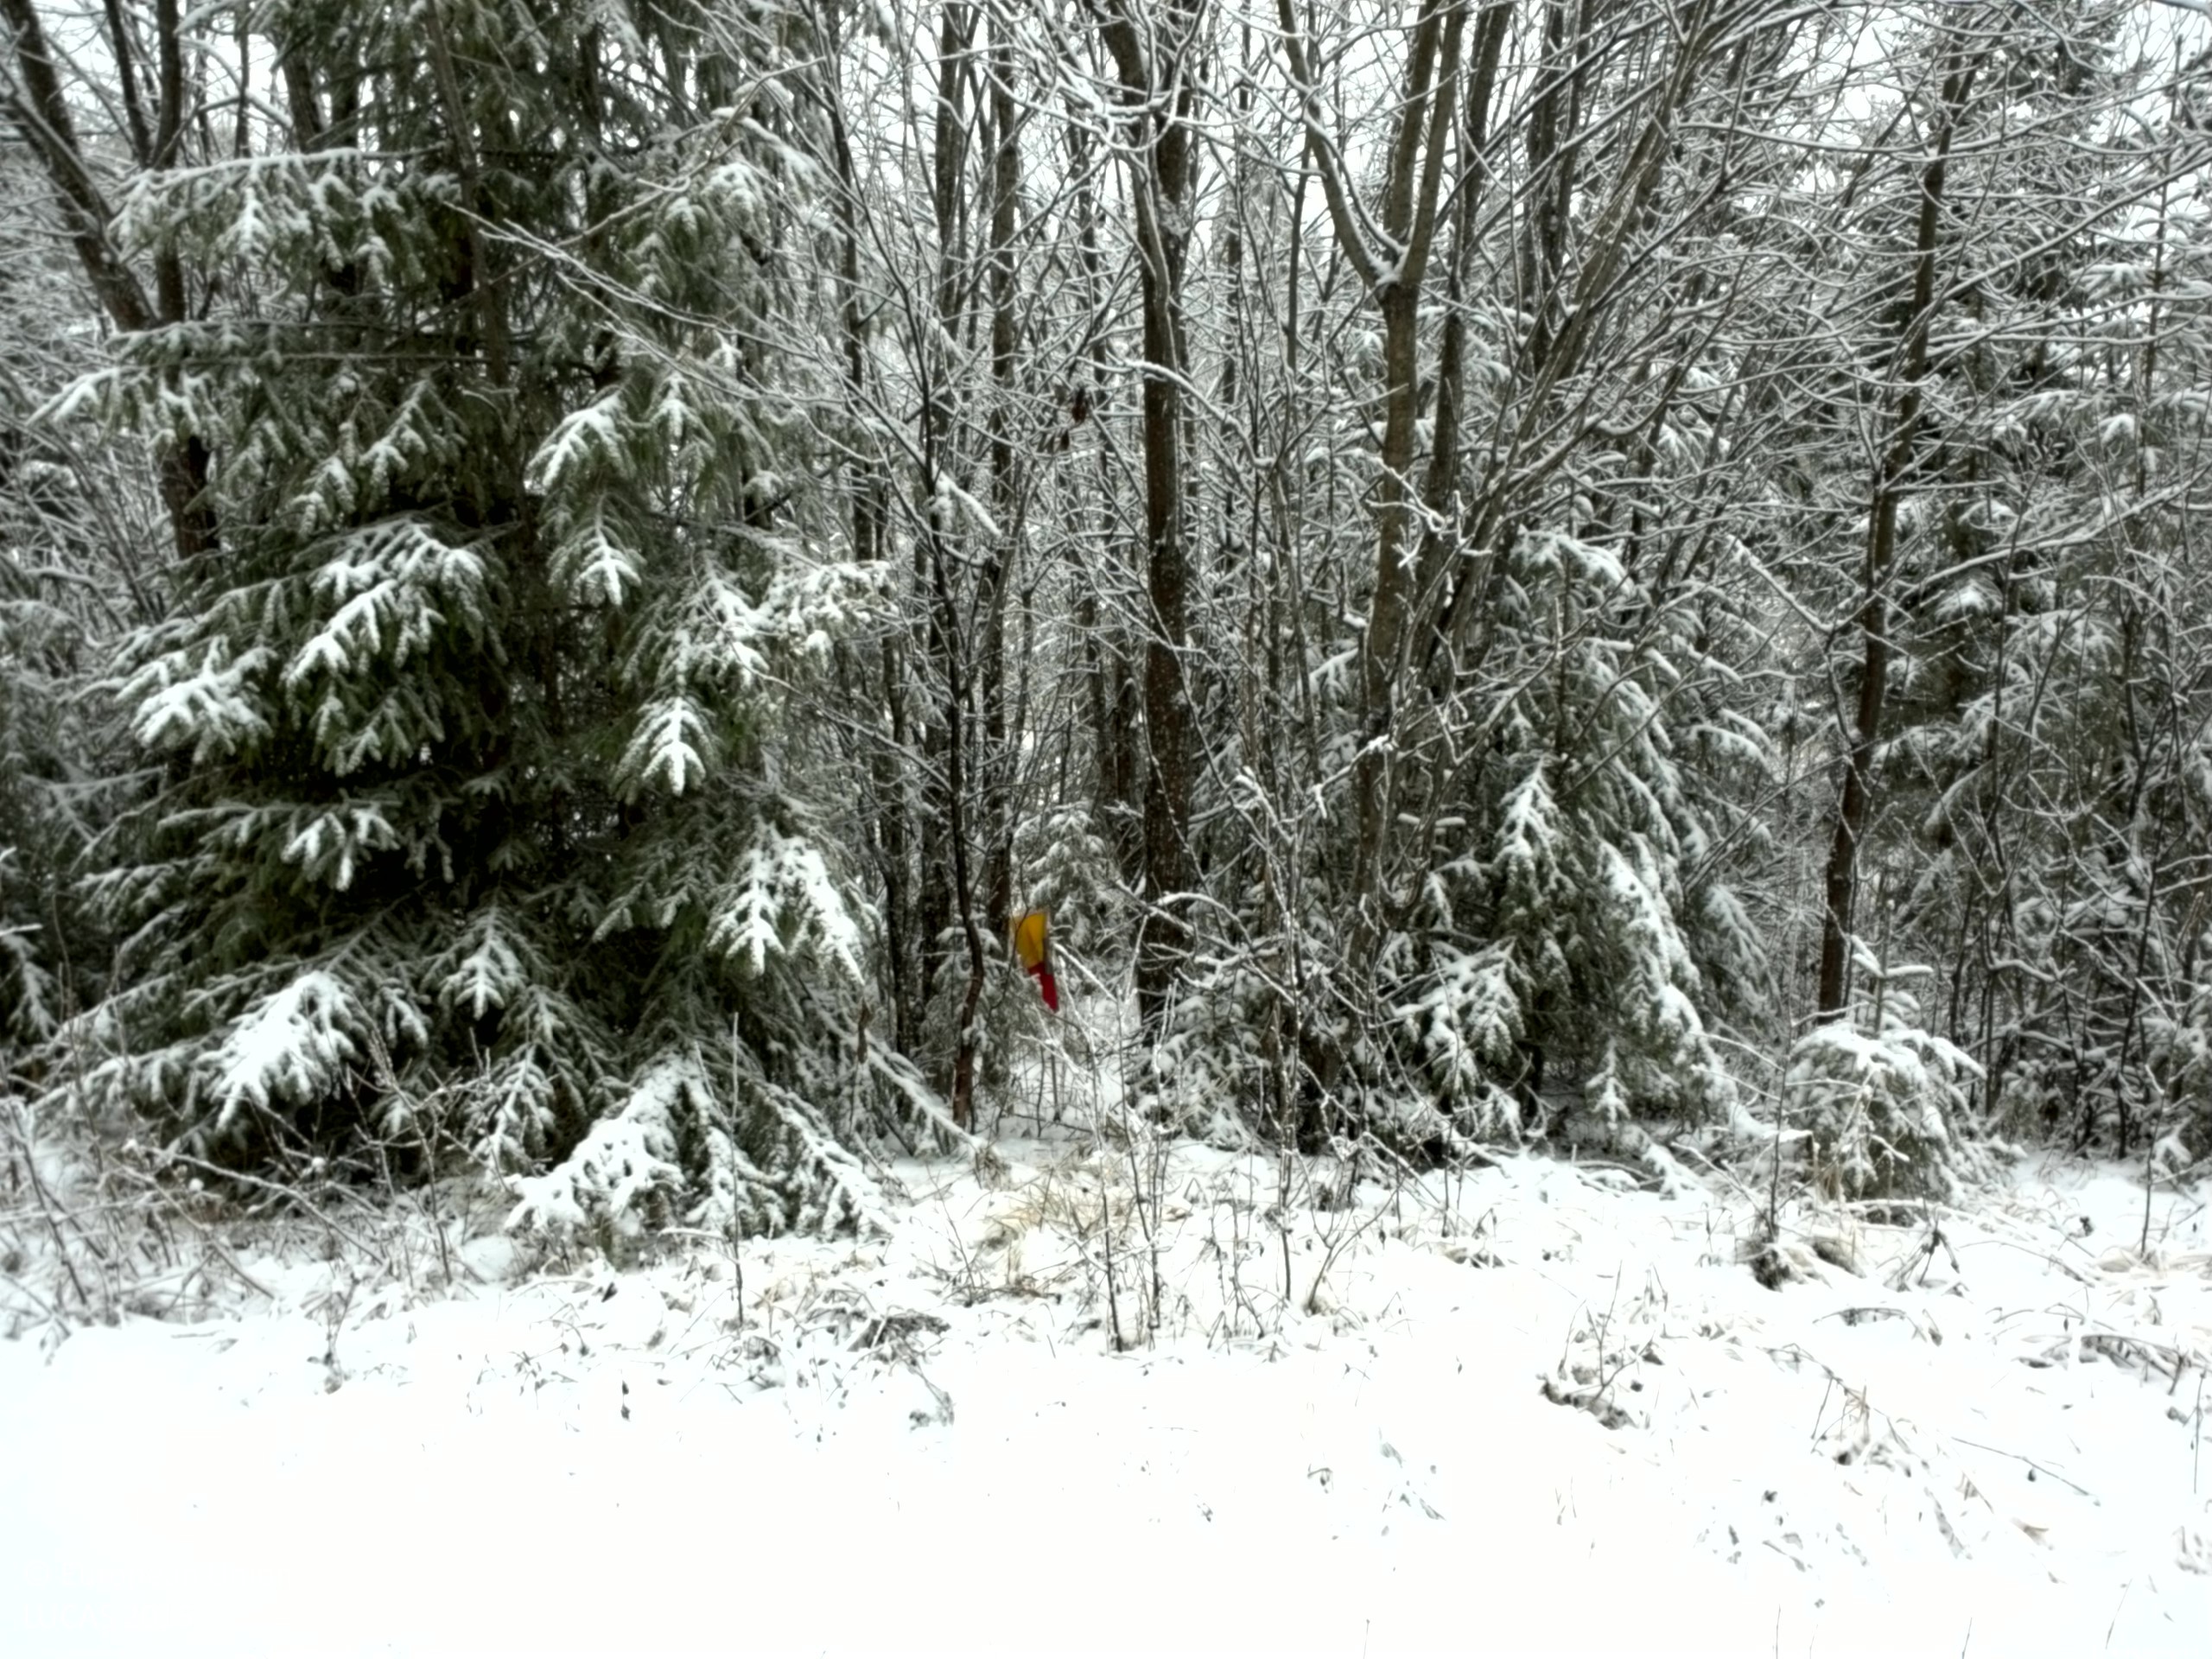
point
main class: Woodland
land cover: Other mixed woodland
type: boreal forest
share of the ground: 50 - 75 %
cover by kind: coniferous forest trees 35 %, broadleaved forest trees 25 %, shrubs 20 %, lichens and mosses 15 %, herbaceous plants 5 %
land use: Forestry
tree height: > 5 m
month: November
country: SE
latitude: 63.6739
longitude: 15.3709
